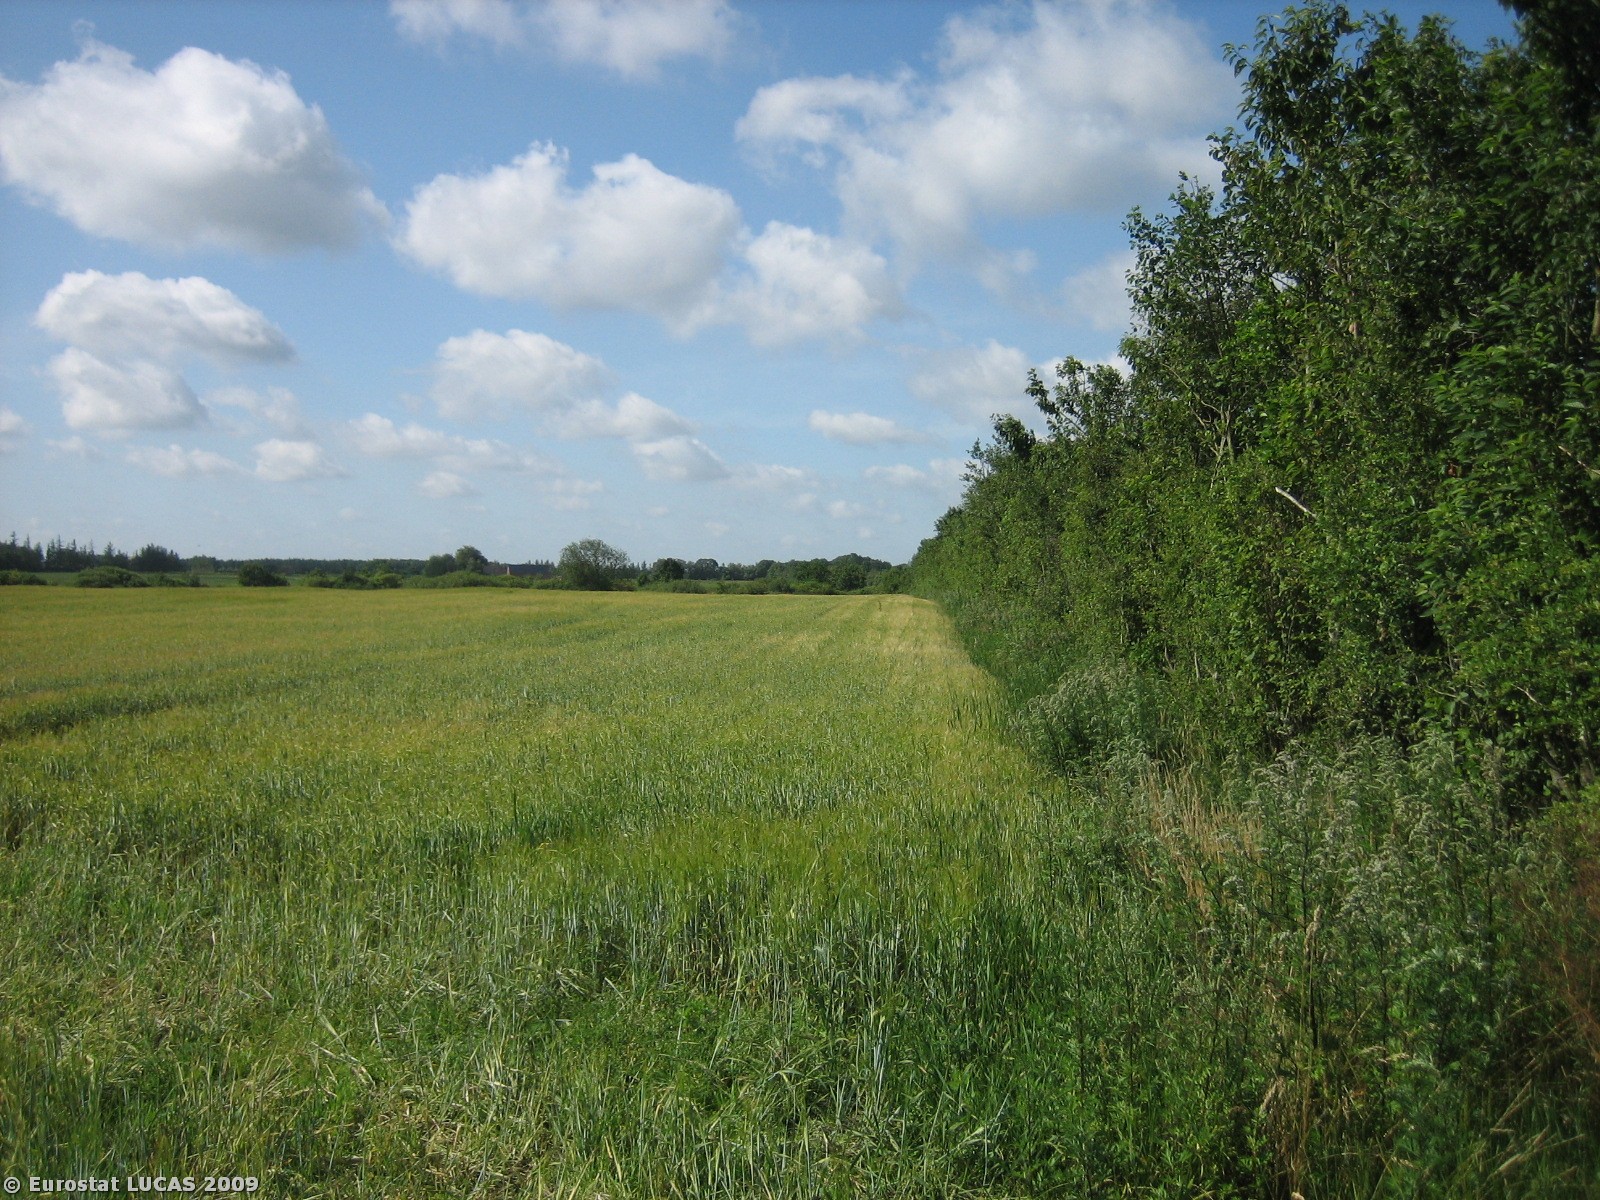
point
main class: Cropland
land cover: Barley
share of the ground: > 75 %
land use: Agriculture (excluding fallow land and kitchen gardens)
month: July
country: DK
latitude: 55.7328
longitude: 8.8068
